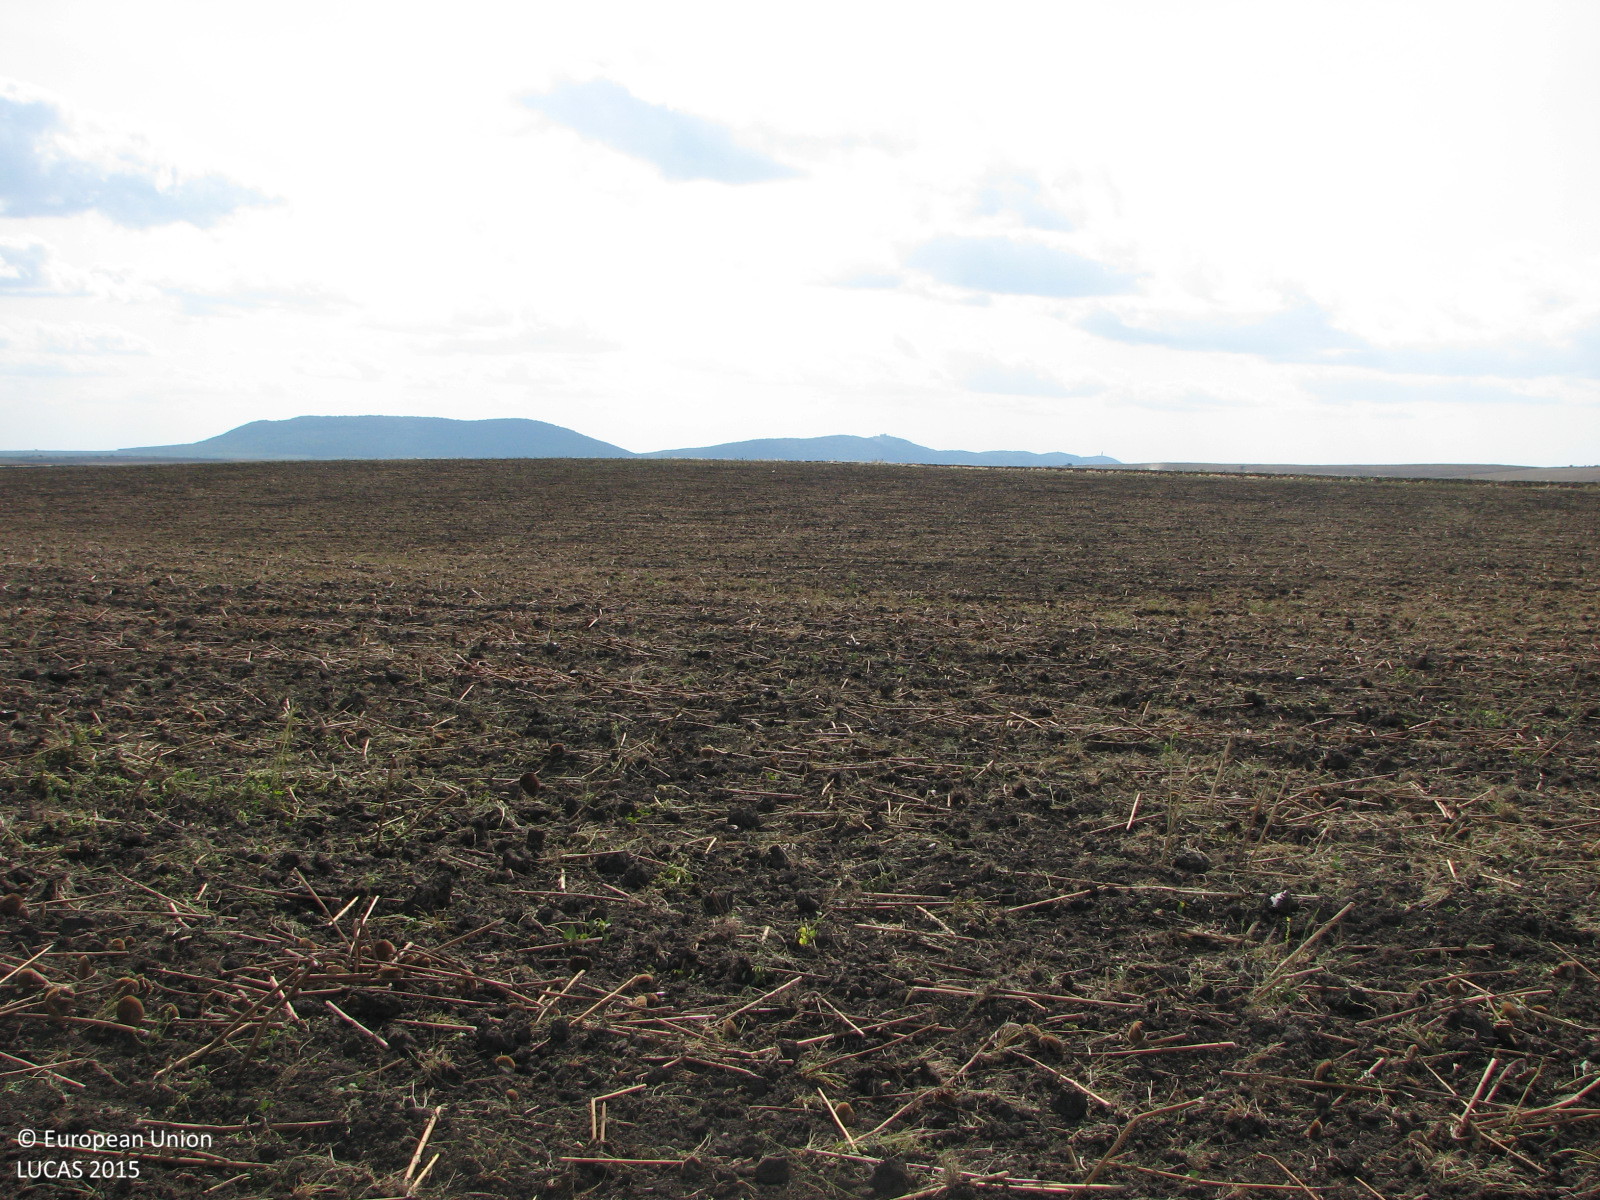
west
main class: Cropland
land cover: Sunflower
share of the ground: < 10 %
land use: Agriculture (excluding fallow land and kitchen gardens)
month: September
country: BG
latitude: 42.4938
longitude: 26.7804
